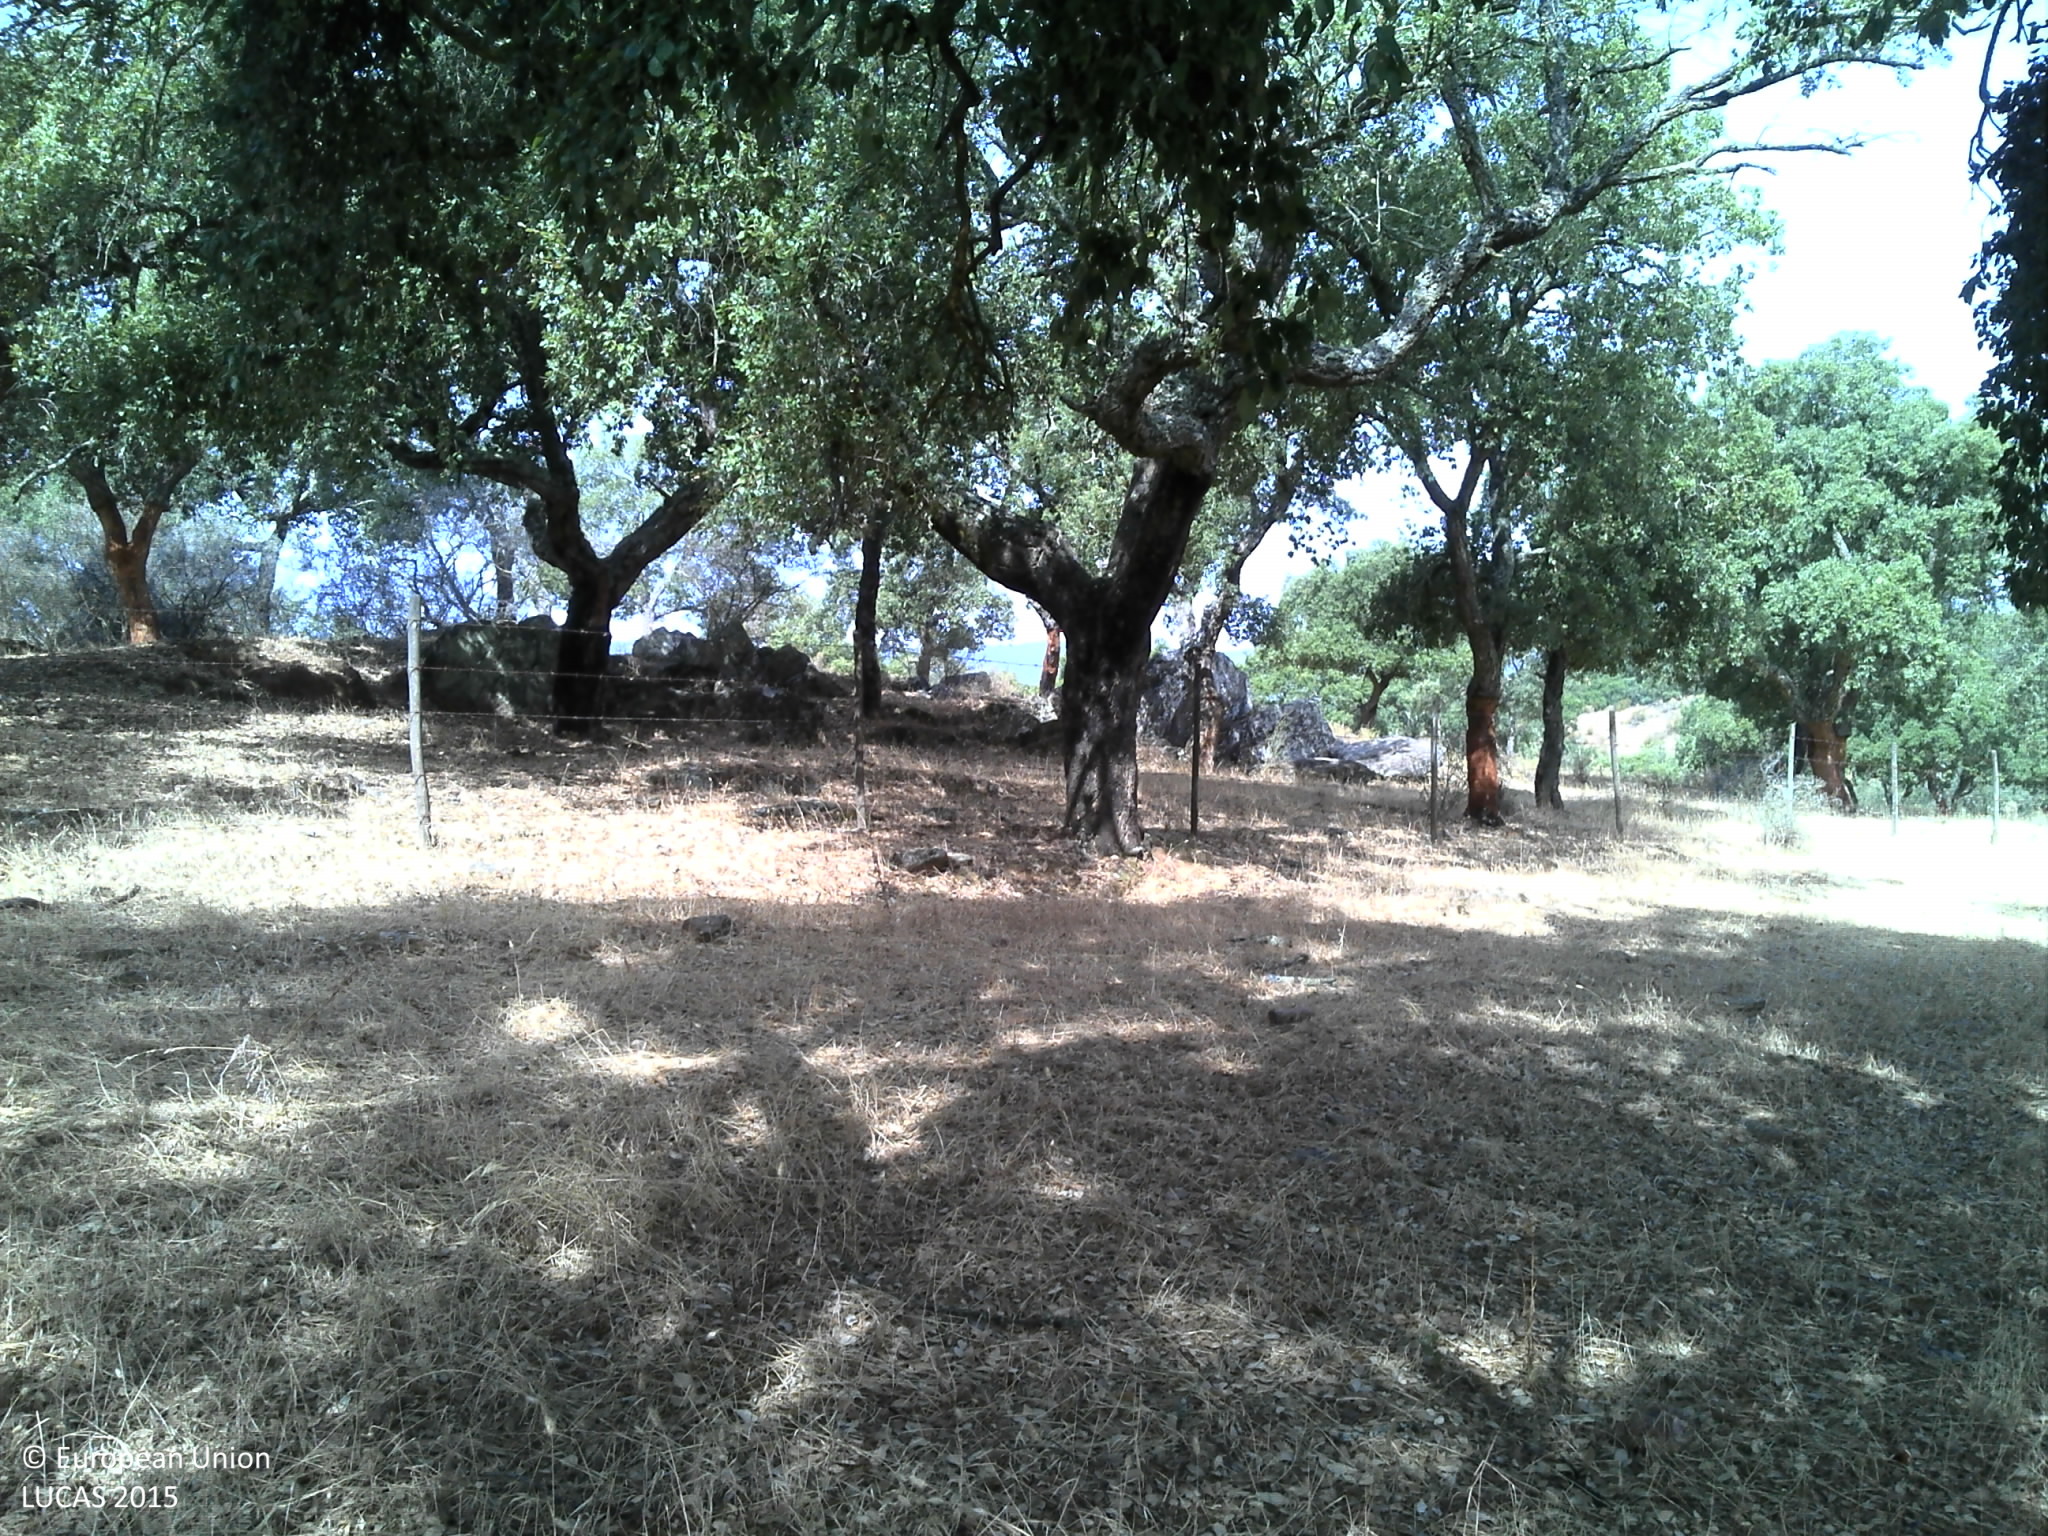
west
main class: Woodland
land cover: Broadleaved woodland
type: broadleaved evergreen forest
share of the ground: 50 - 75 %
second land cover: Grassland without tree/shrub cover
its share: 50 - 75 %
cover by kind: broadleaved forest trees 50 %, herbaceous plants 50 %
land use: Forestry
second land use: Agriculture (excluding fallow land and kitchen gardens)
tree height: > 5 m
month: July
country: PT
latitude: 38.7563
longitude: -7.4897
